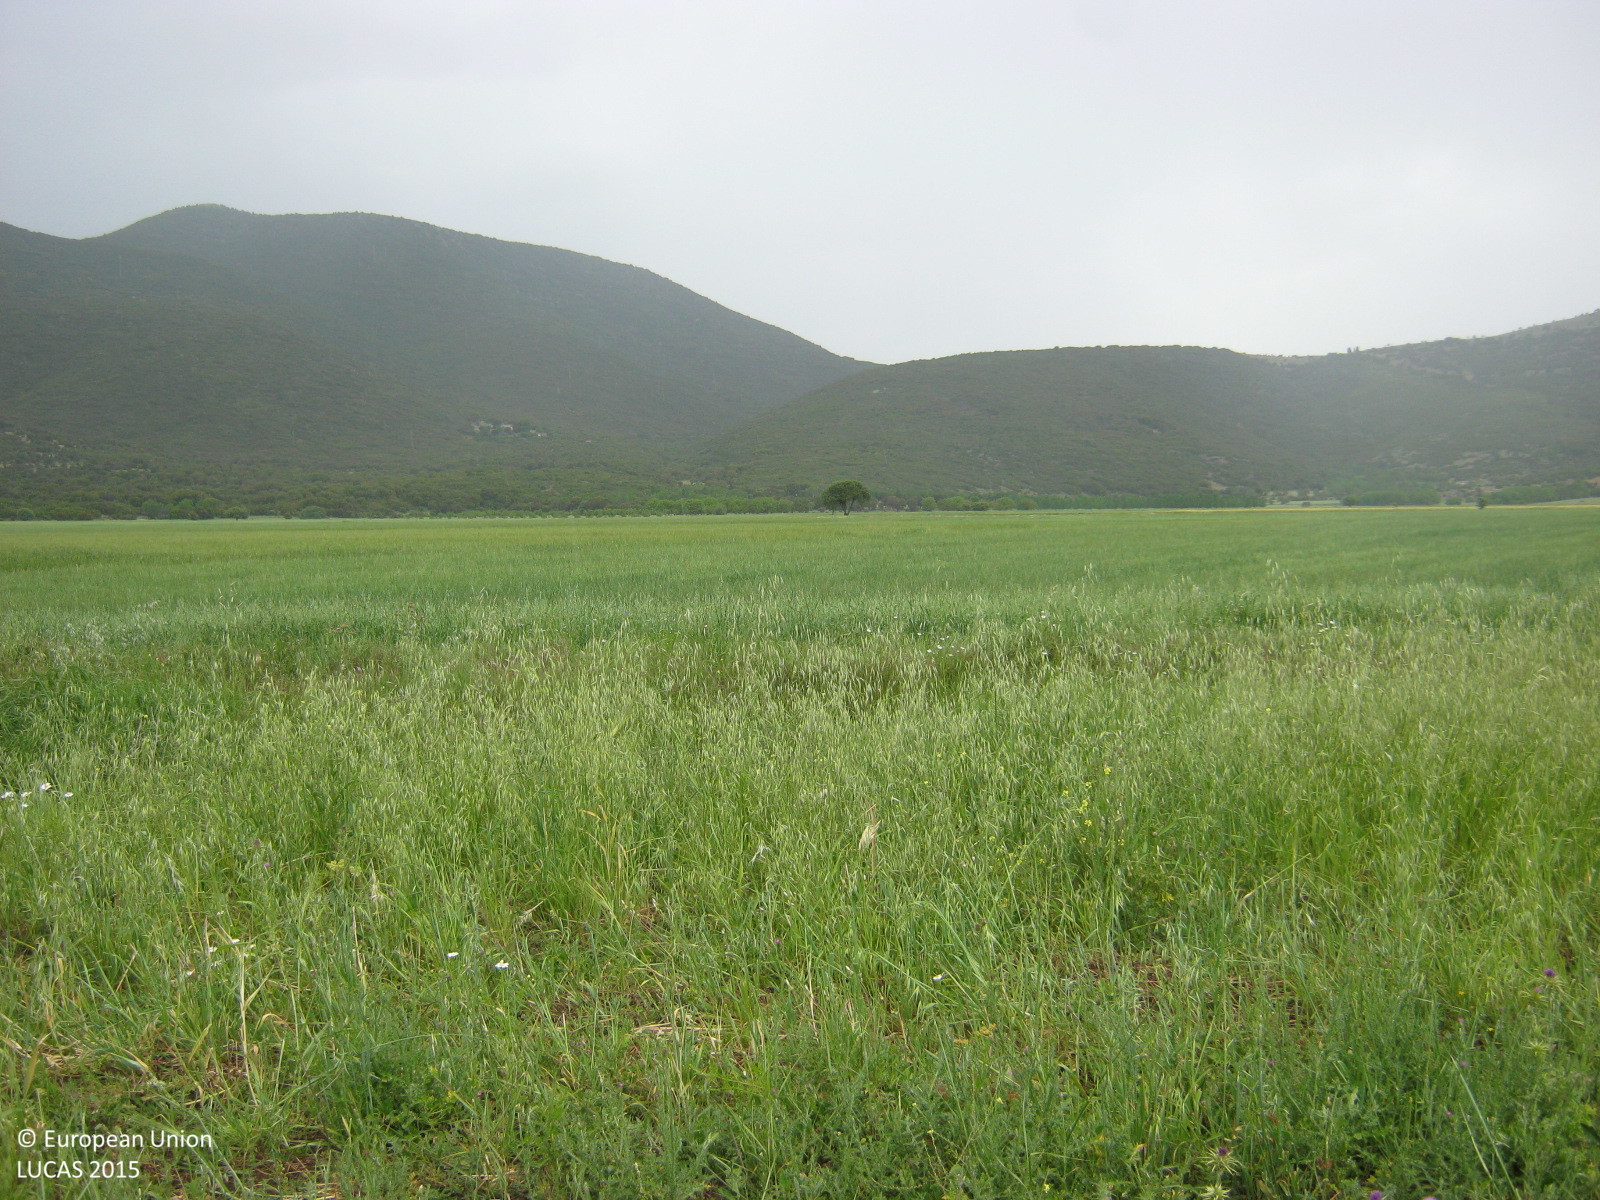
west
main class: Cropland
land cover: Oats
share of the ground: > 75 %
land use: Agriculture (excluding fallow land and kitchen gardens)
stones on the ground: < 10 %
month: May
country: GR
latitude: 37.6534
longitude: 22.3526
